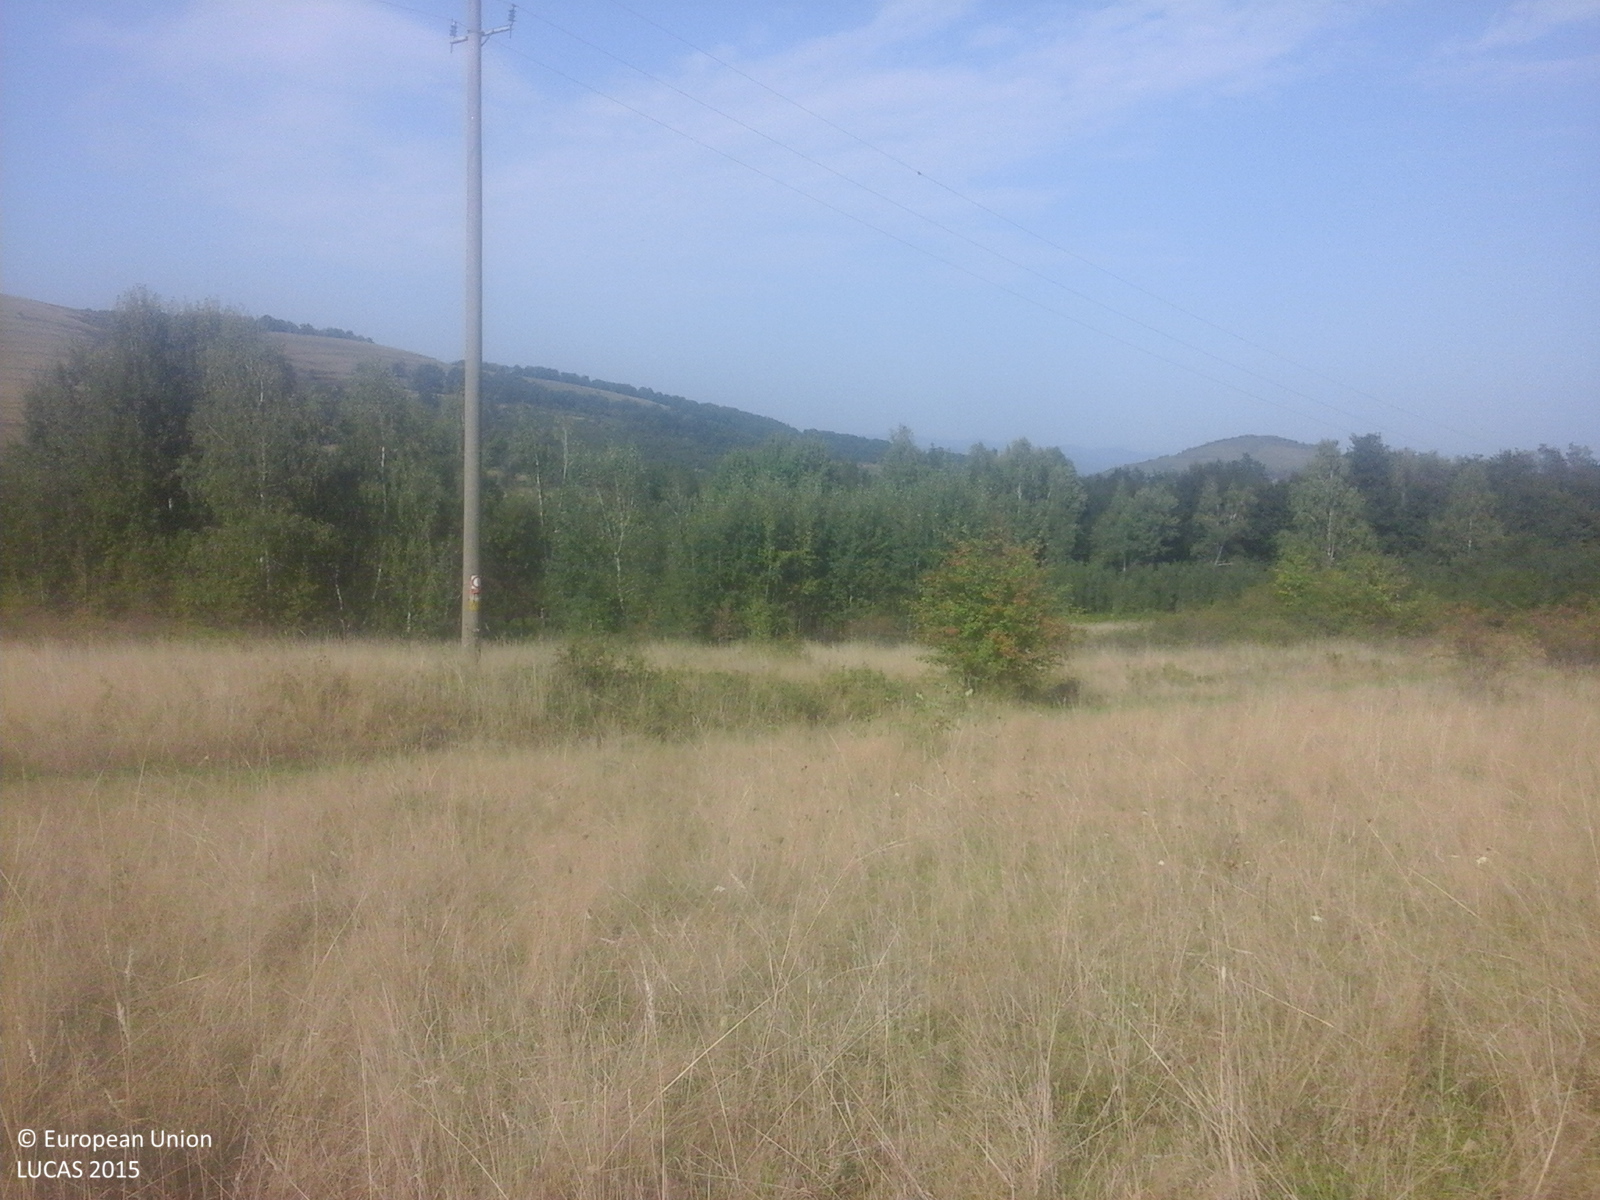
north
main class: Grassland
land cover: Grassland with sparse tree/shrub cover
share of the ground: > 75 %
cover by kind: herbaceous plants 85 %, shrubs 10 %, broadleaved forest trees 5 %
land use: Agriculture (excluding fallow land and kitchen gardens)
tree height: < 5 m
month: September
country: RO
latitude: 45.8514
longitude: 22.5006
